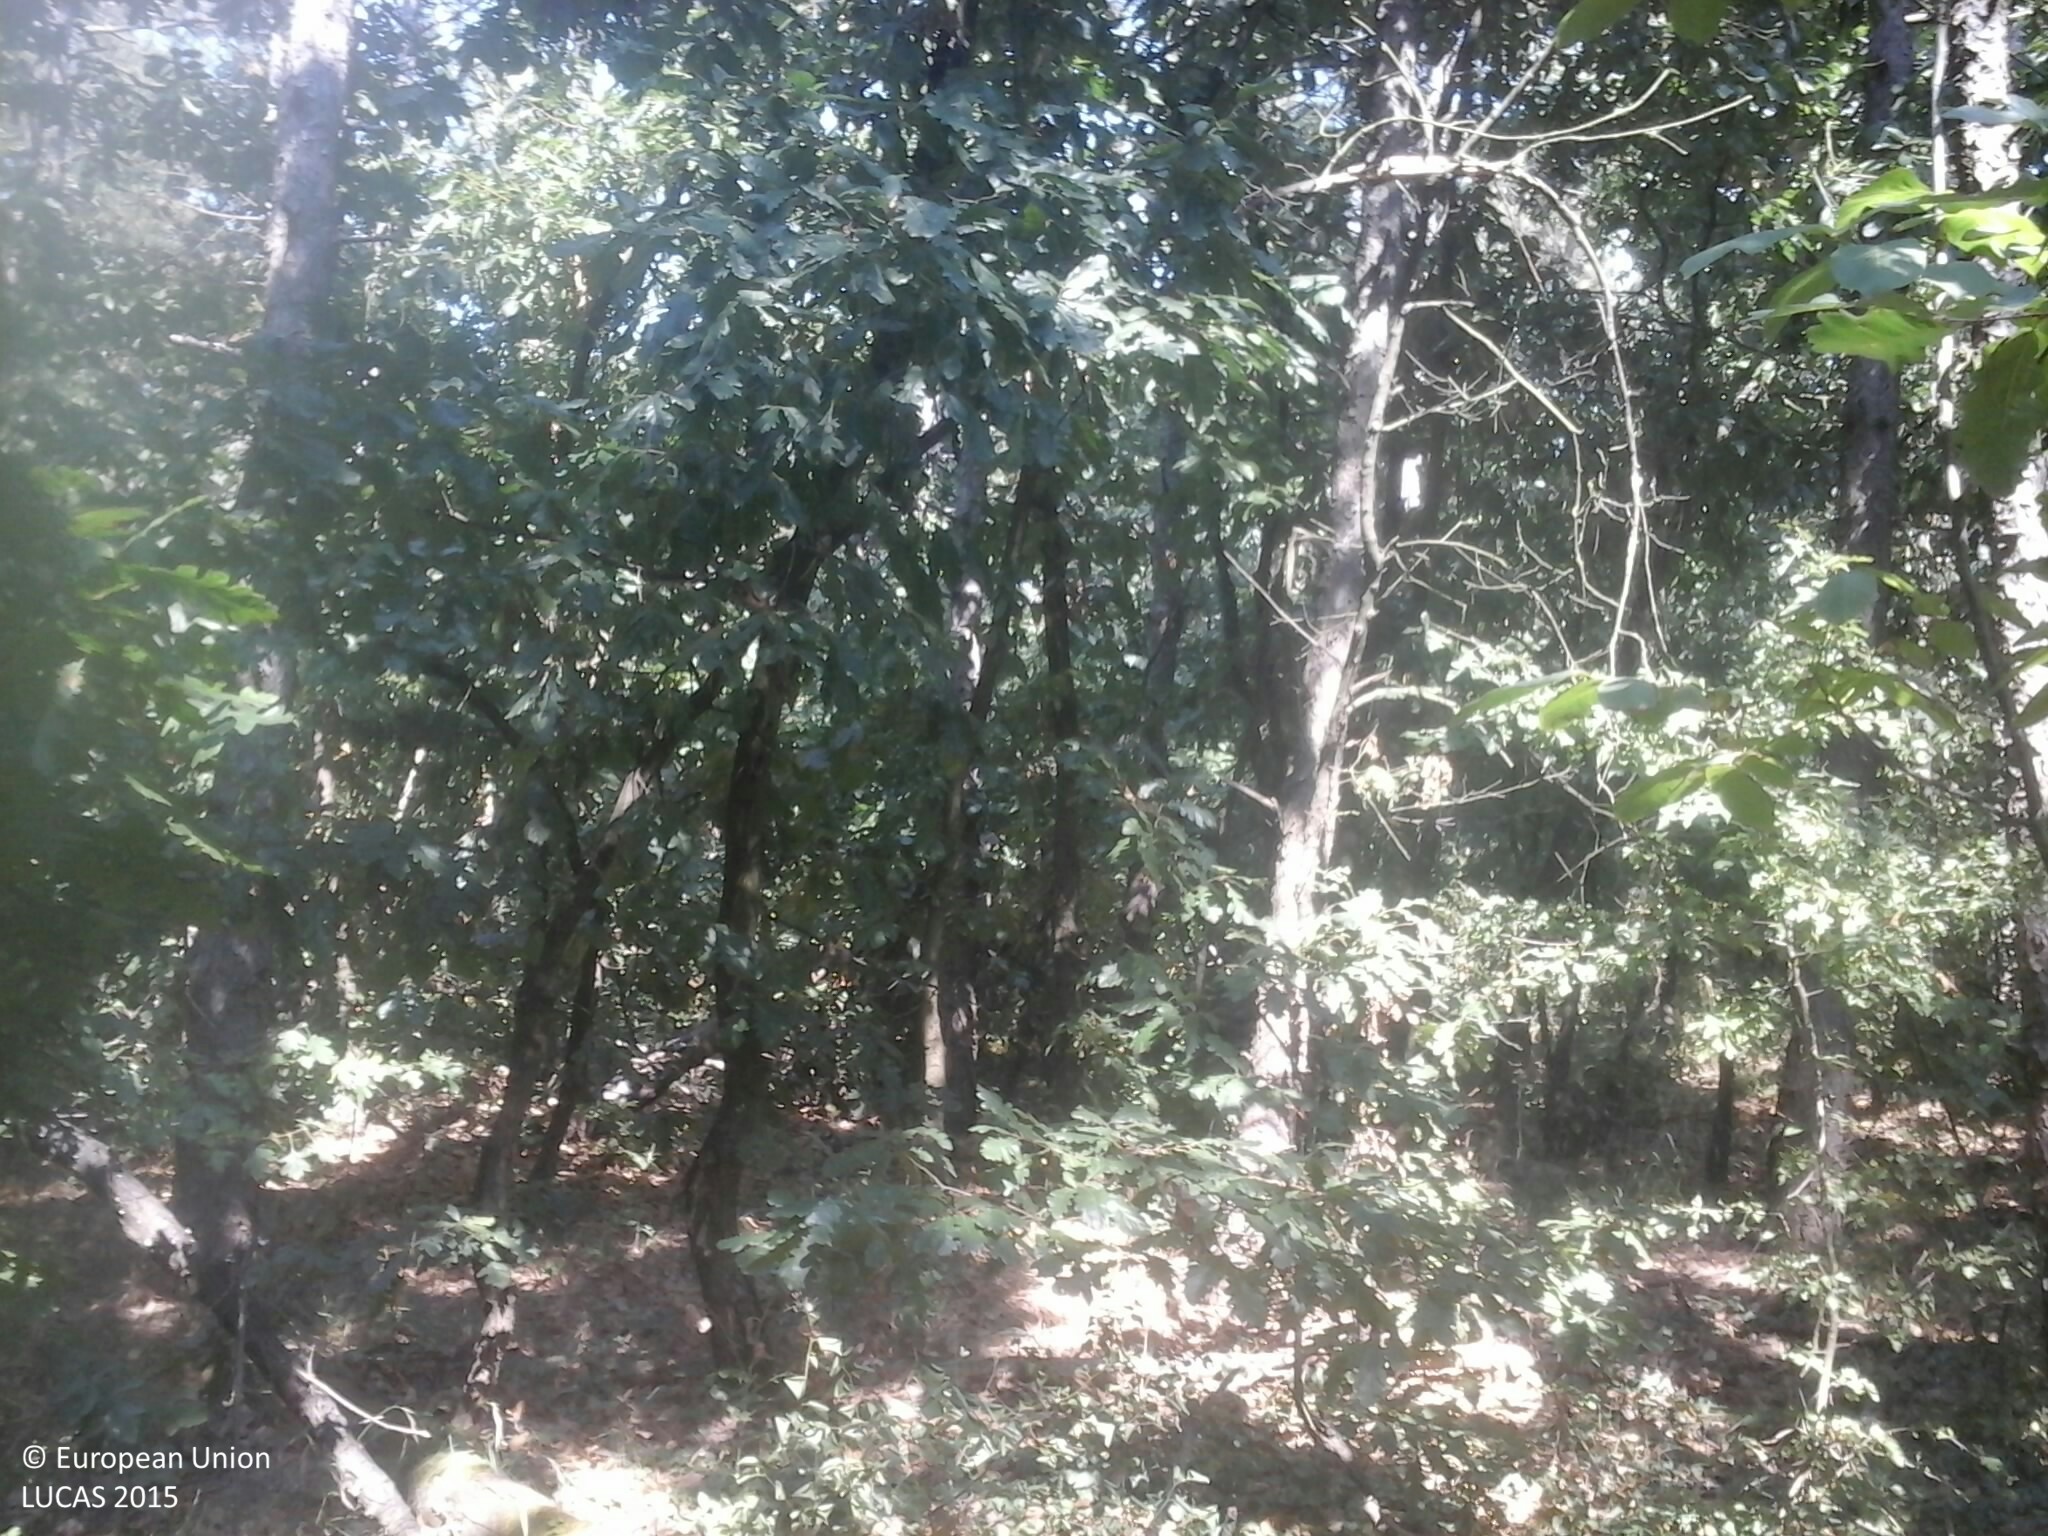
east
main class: Woodland
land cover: Pine dominated mixed woodland
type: hemiboreal forest and nemoral coniferous forest and mixed broadleaved-coniferous forest
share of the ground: > 75 %
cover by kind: coniferous forest trees 70 %, broadleaved forest trees 25 %, herbaceous plants 5 %
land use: Forestry
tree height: > 5 m
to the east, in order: Pine dominated mixed woodland; Grass margins; Tracks; Grass margins; Pine dominated mixed woodland
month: July
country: HU
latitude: 46.9890
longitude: 17.2766
